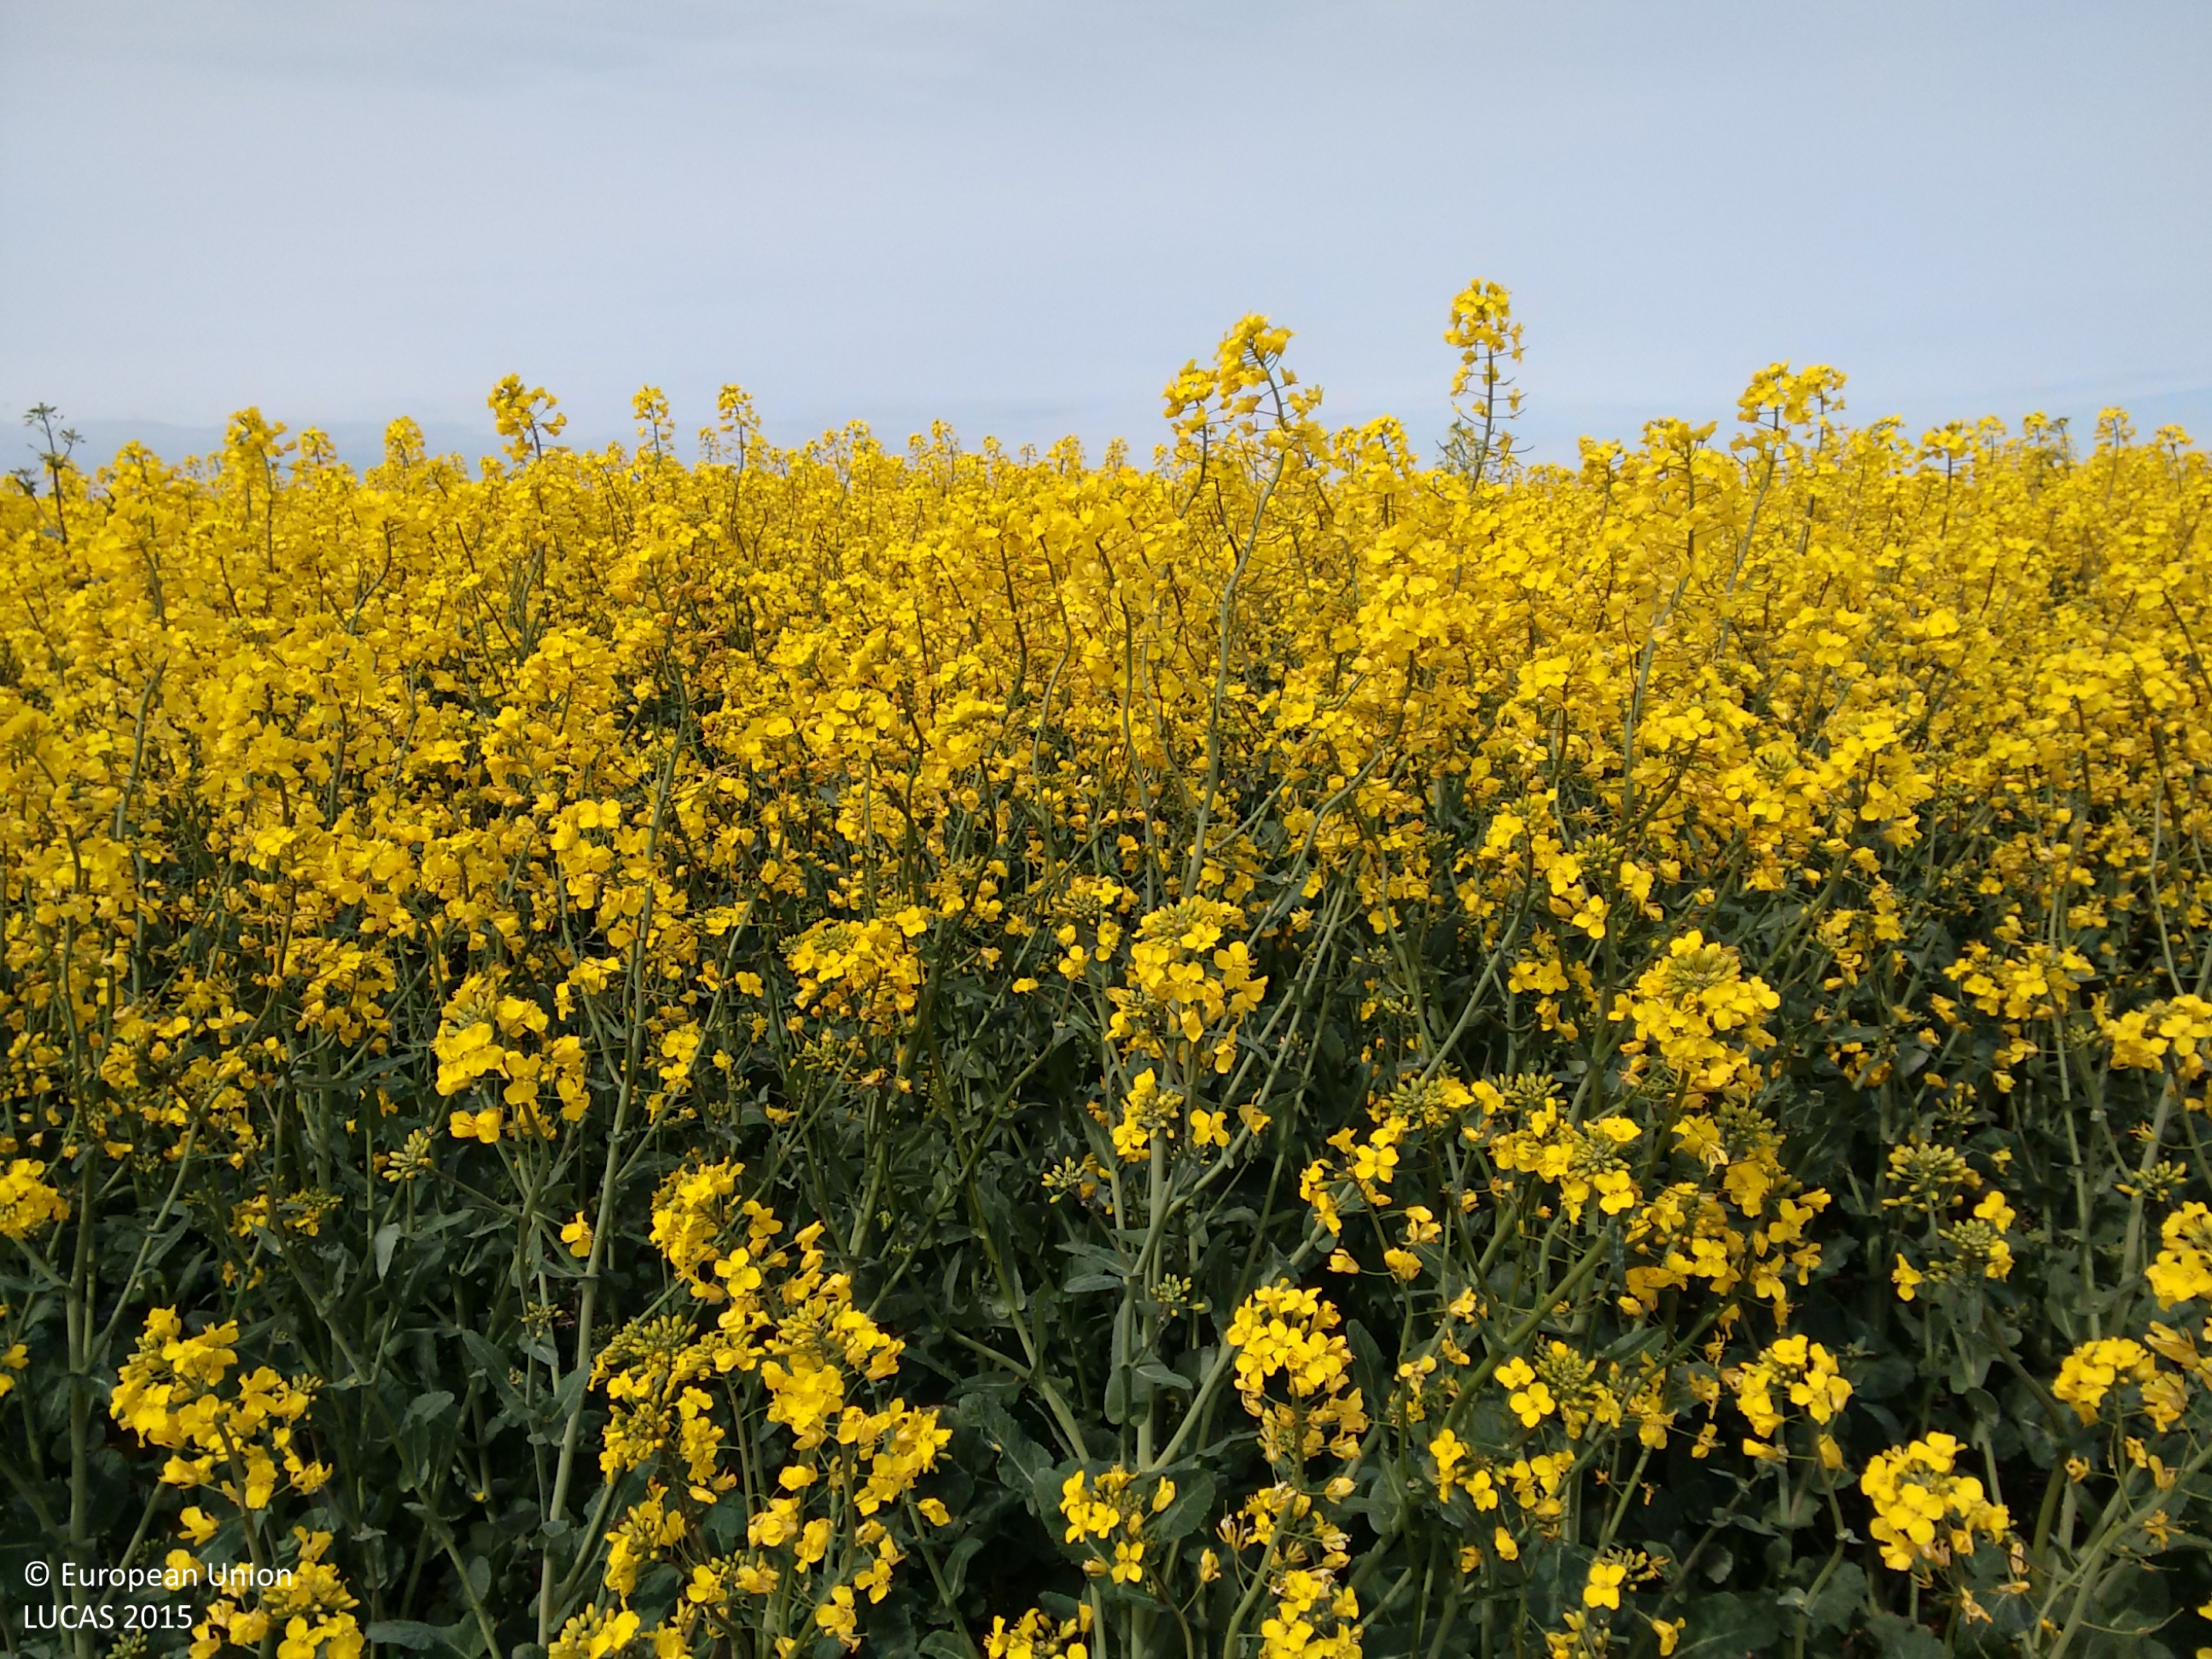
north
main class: Cropland
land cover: Rape and turnip rape
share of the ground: > 75 %
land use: Agriculture (excluding fallow land and kitchen gardens)
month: May
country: GB
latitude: 53.3090
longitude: 0.1696
